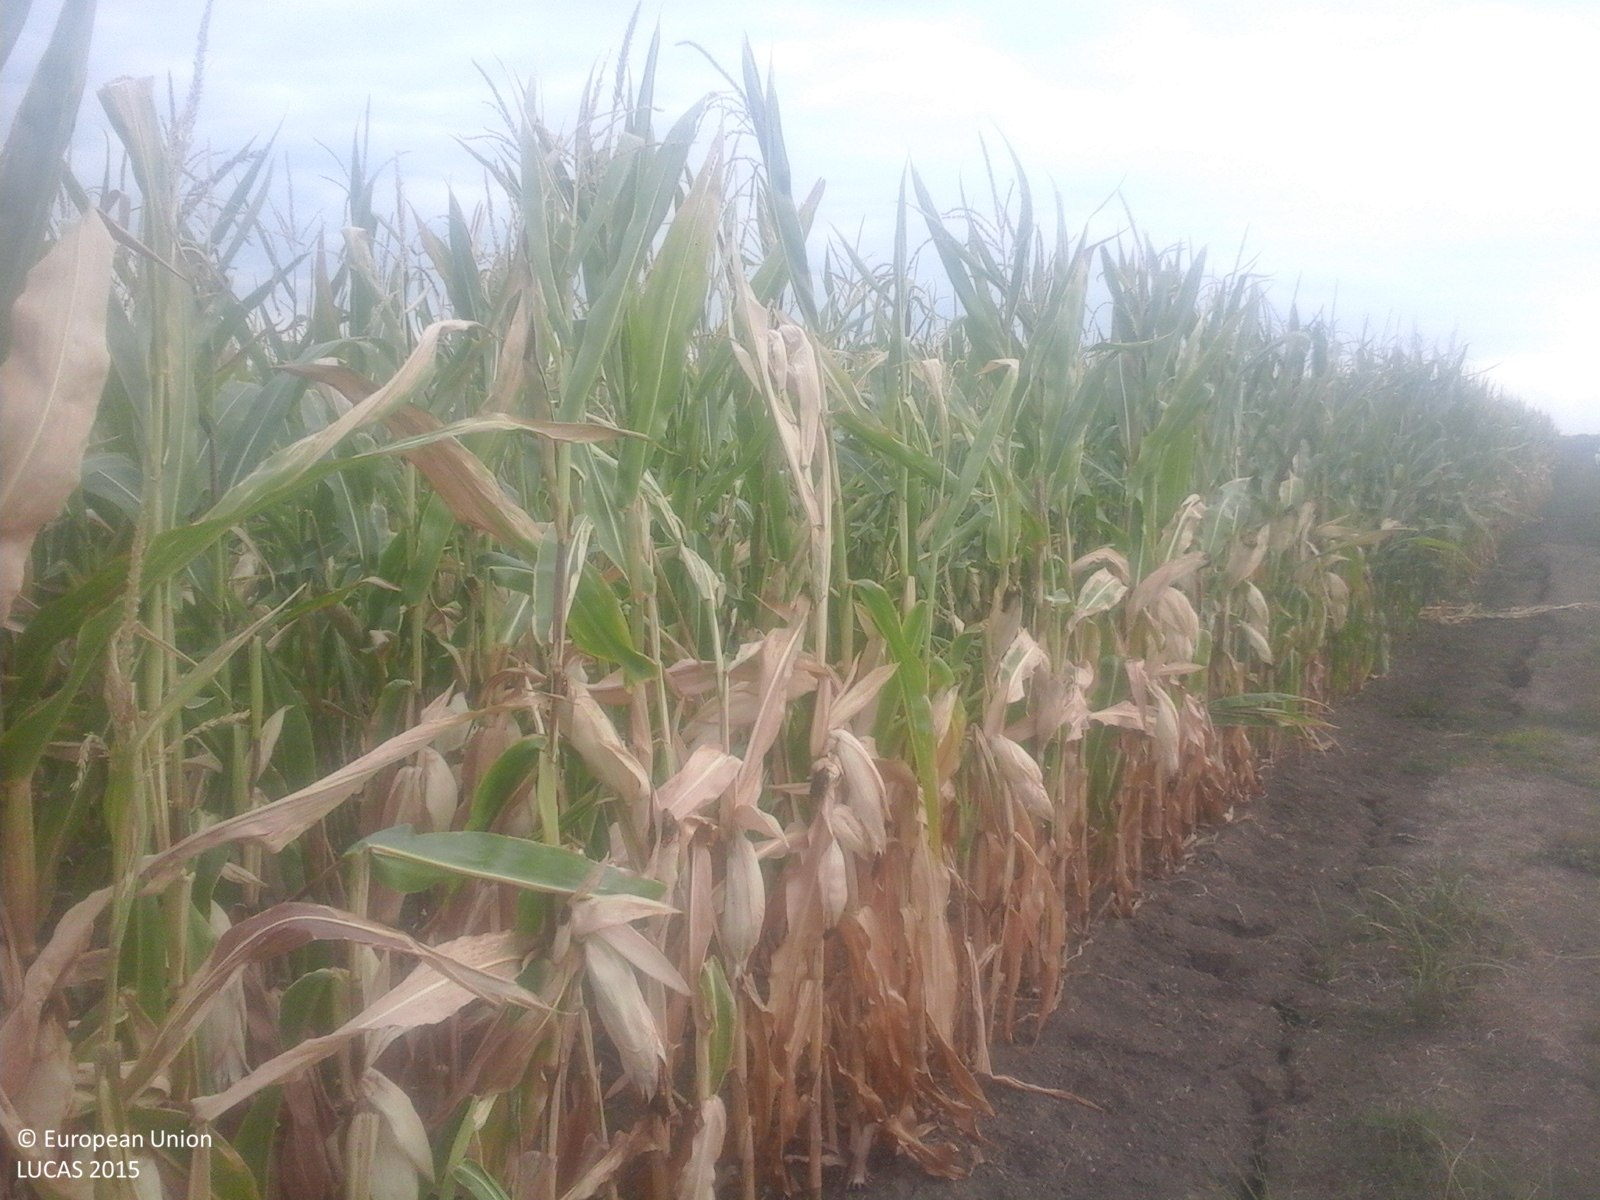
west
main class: Cropland
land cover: Maize
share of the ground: > 75 %
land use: Agriculture (excluding fallow land and kitchen gardens)
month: September
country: RO
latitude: 47.7685
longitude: 22.6162
